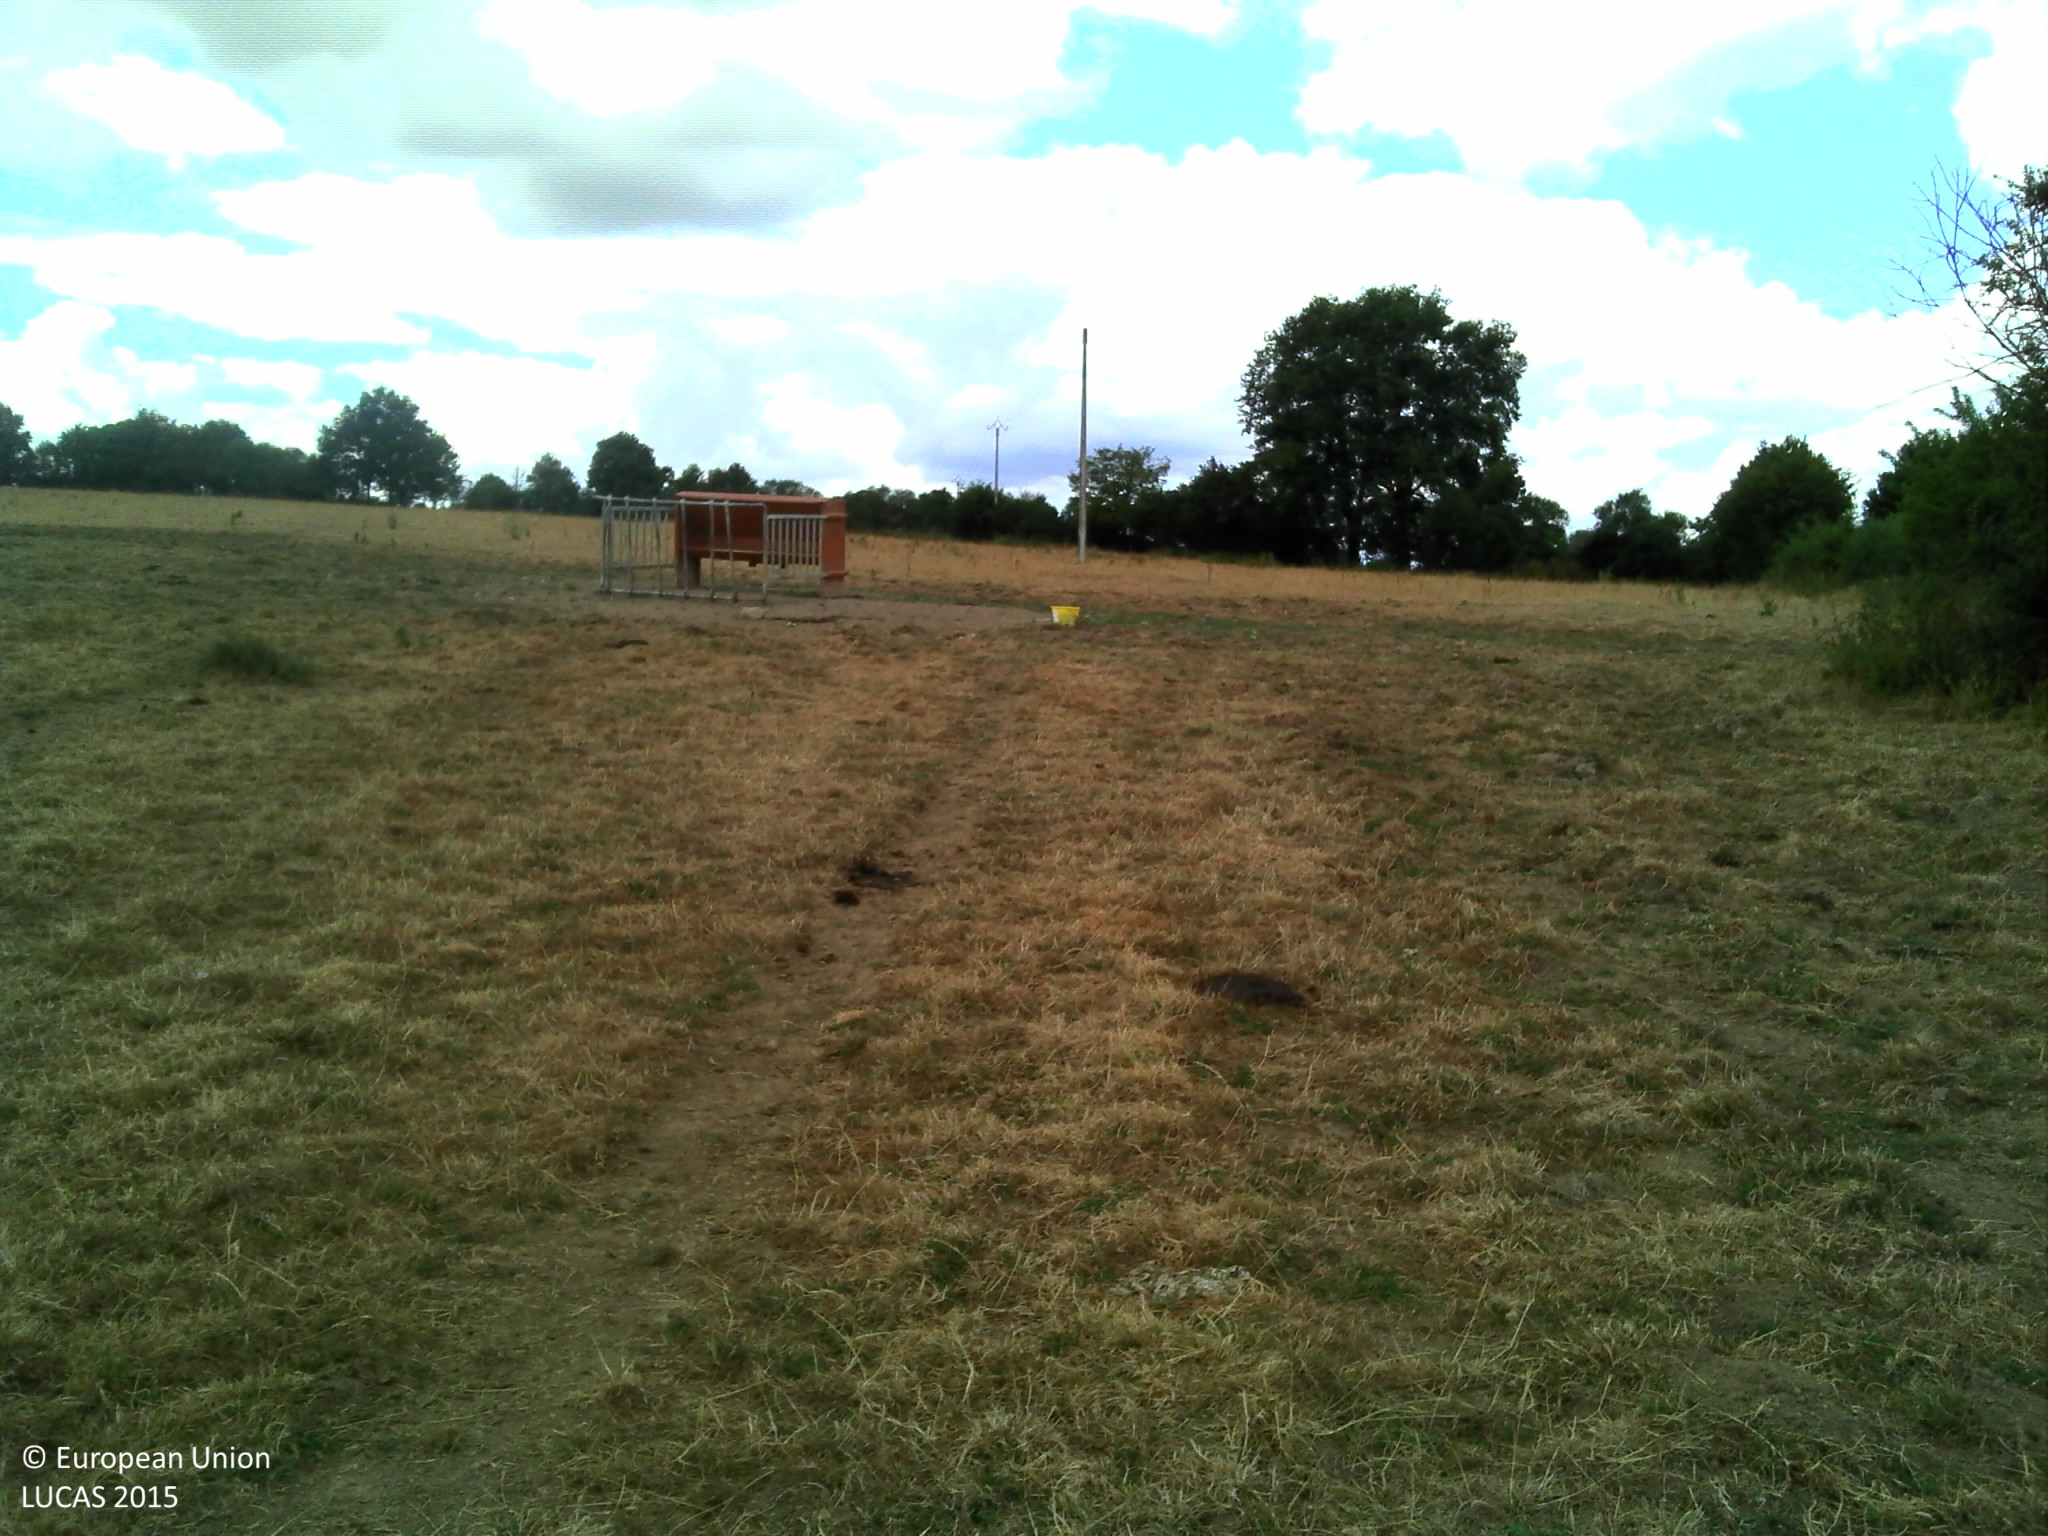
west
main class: Grassland
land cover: Grassland without tree/shrub cover
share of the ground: > 75 %
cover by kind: herbaceous plants 100 %
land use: Agriculture (excluding fallow land and kitchen gardens)
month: July
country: FR
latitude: 46.6605
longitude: 2.1647
